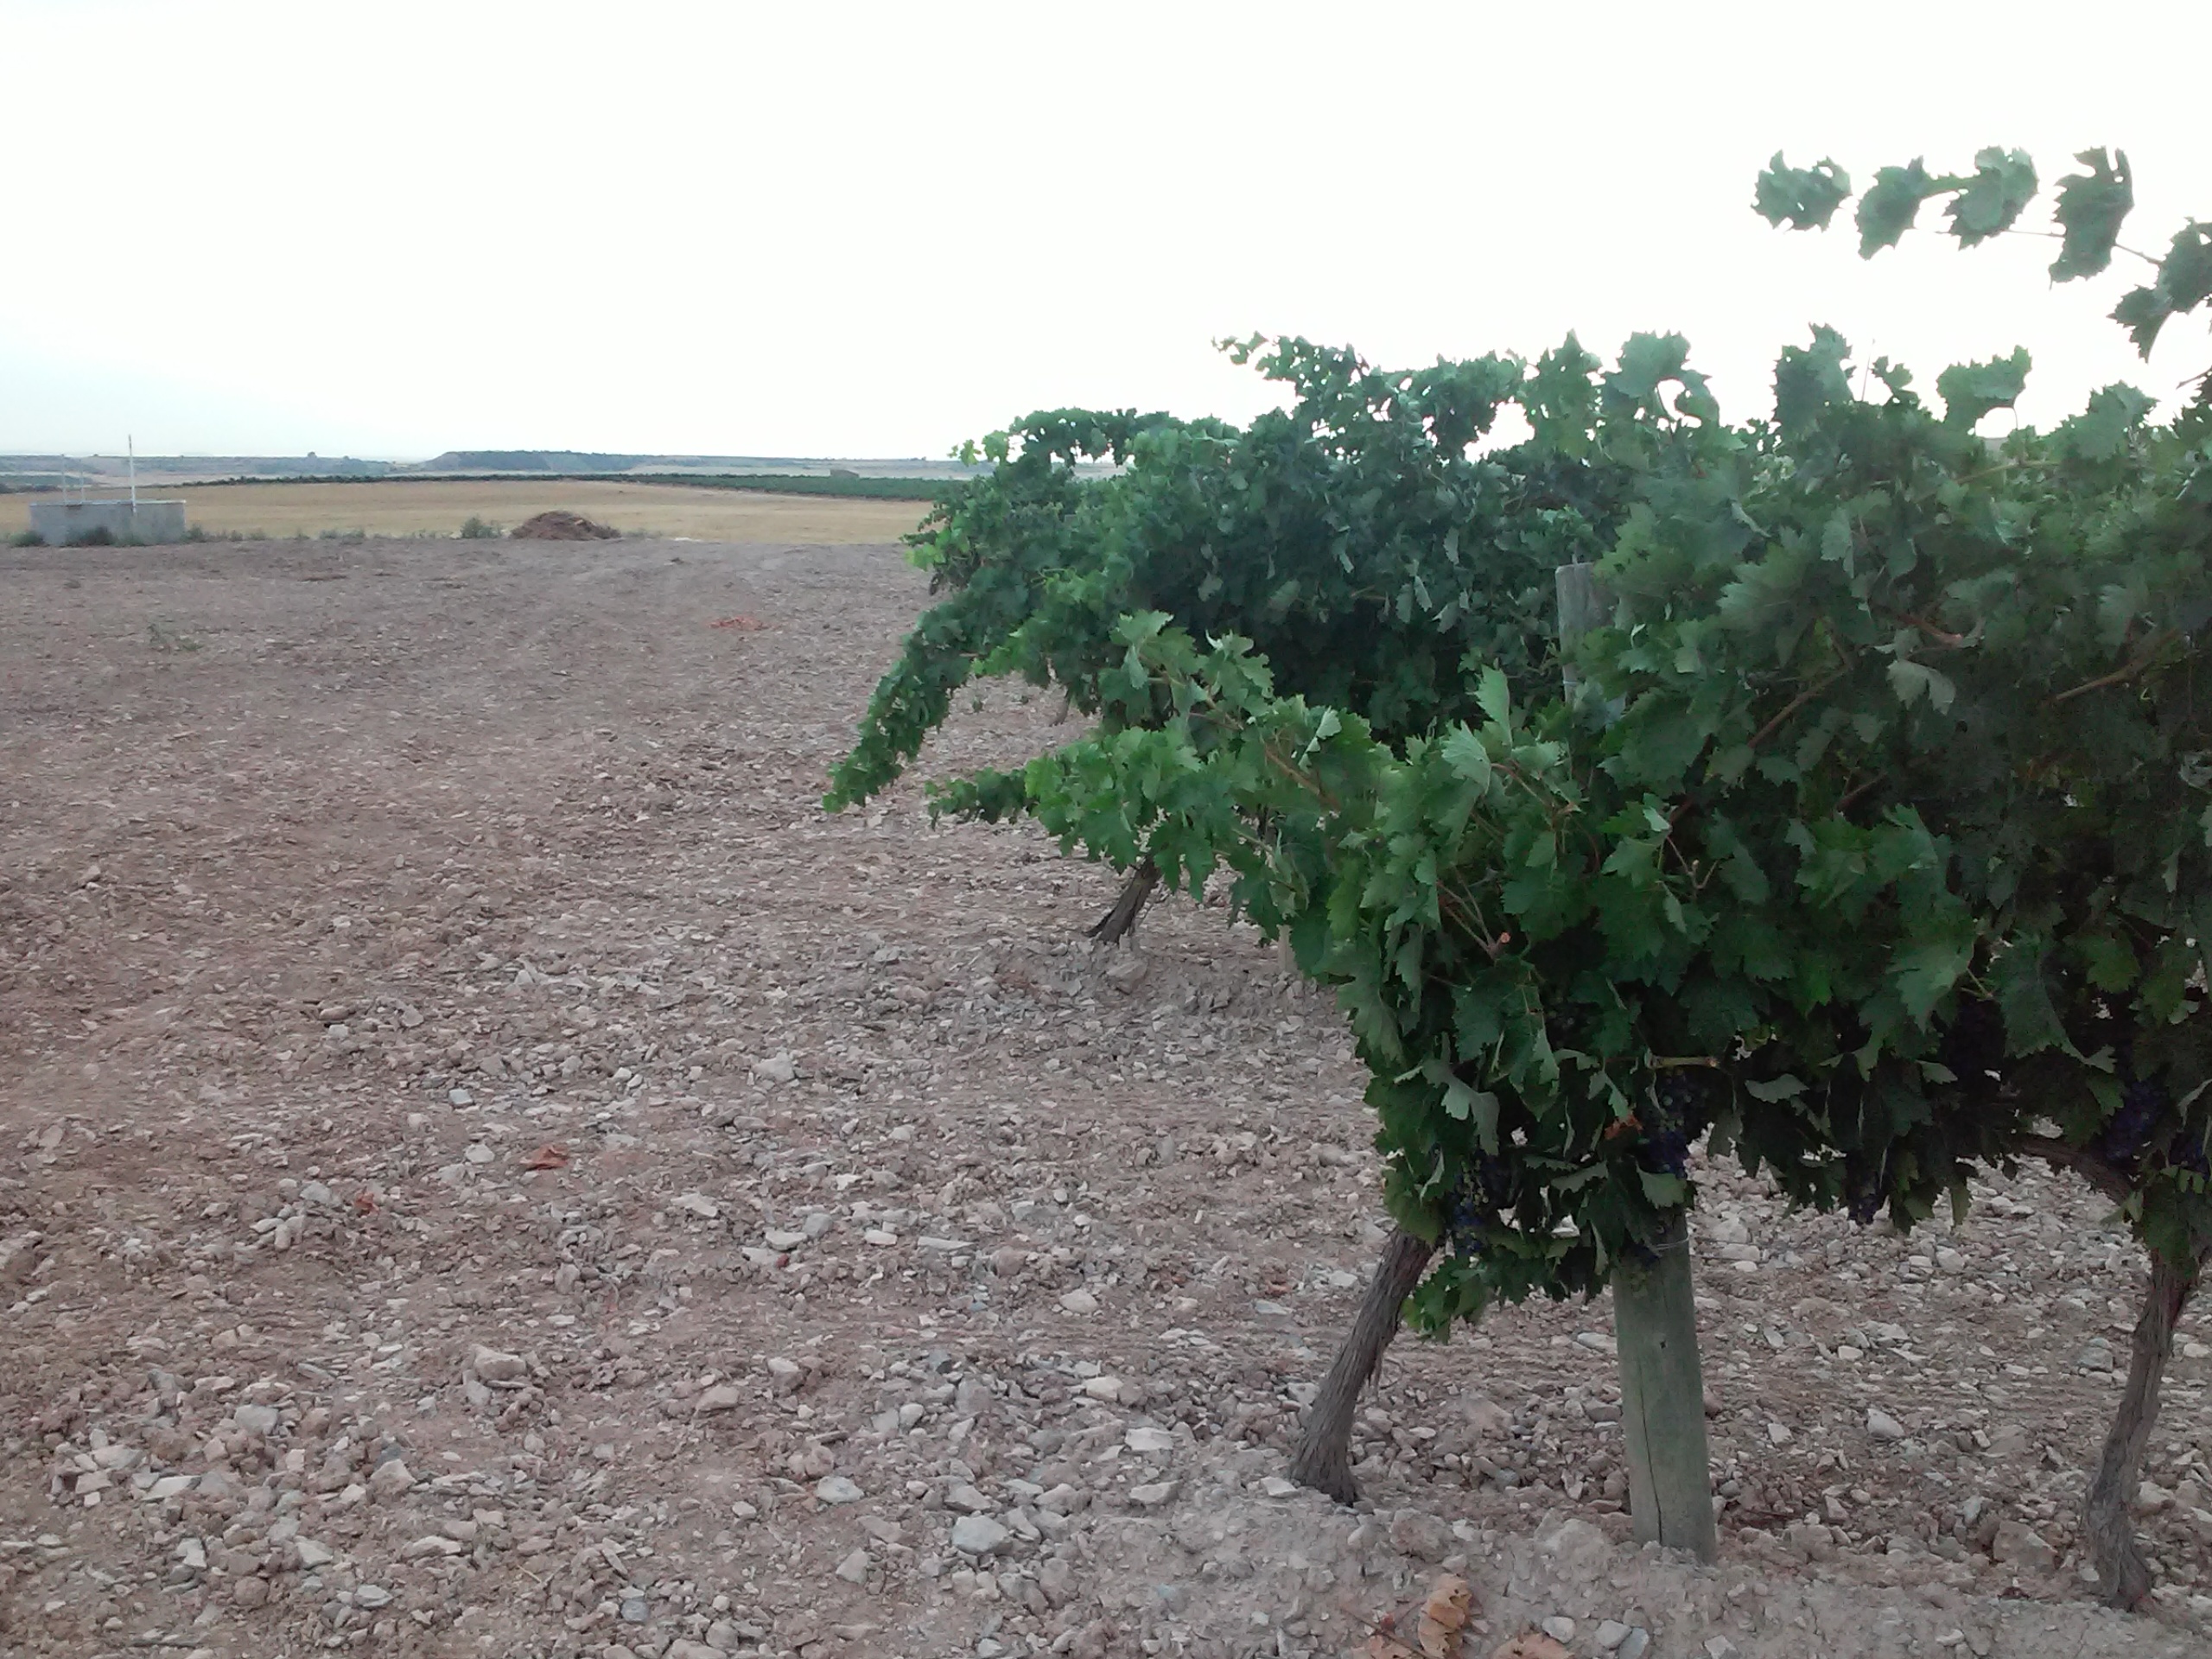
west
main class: Cropland
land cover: Vineyards
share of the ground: < 10 %
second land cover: Other bare soil
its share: > 75 %
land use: Agriculture (excluding fallow land and kitchen gardens)
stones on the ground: 10 - 25 %
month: July
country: ES
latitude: 41.6096
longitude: 1.1220
